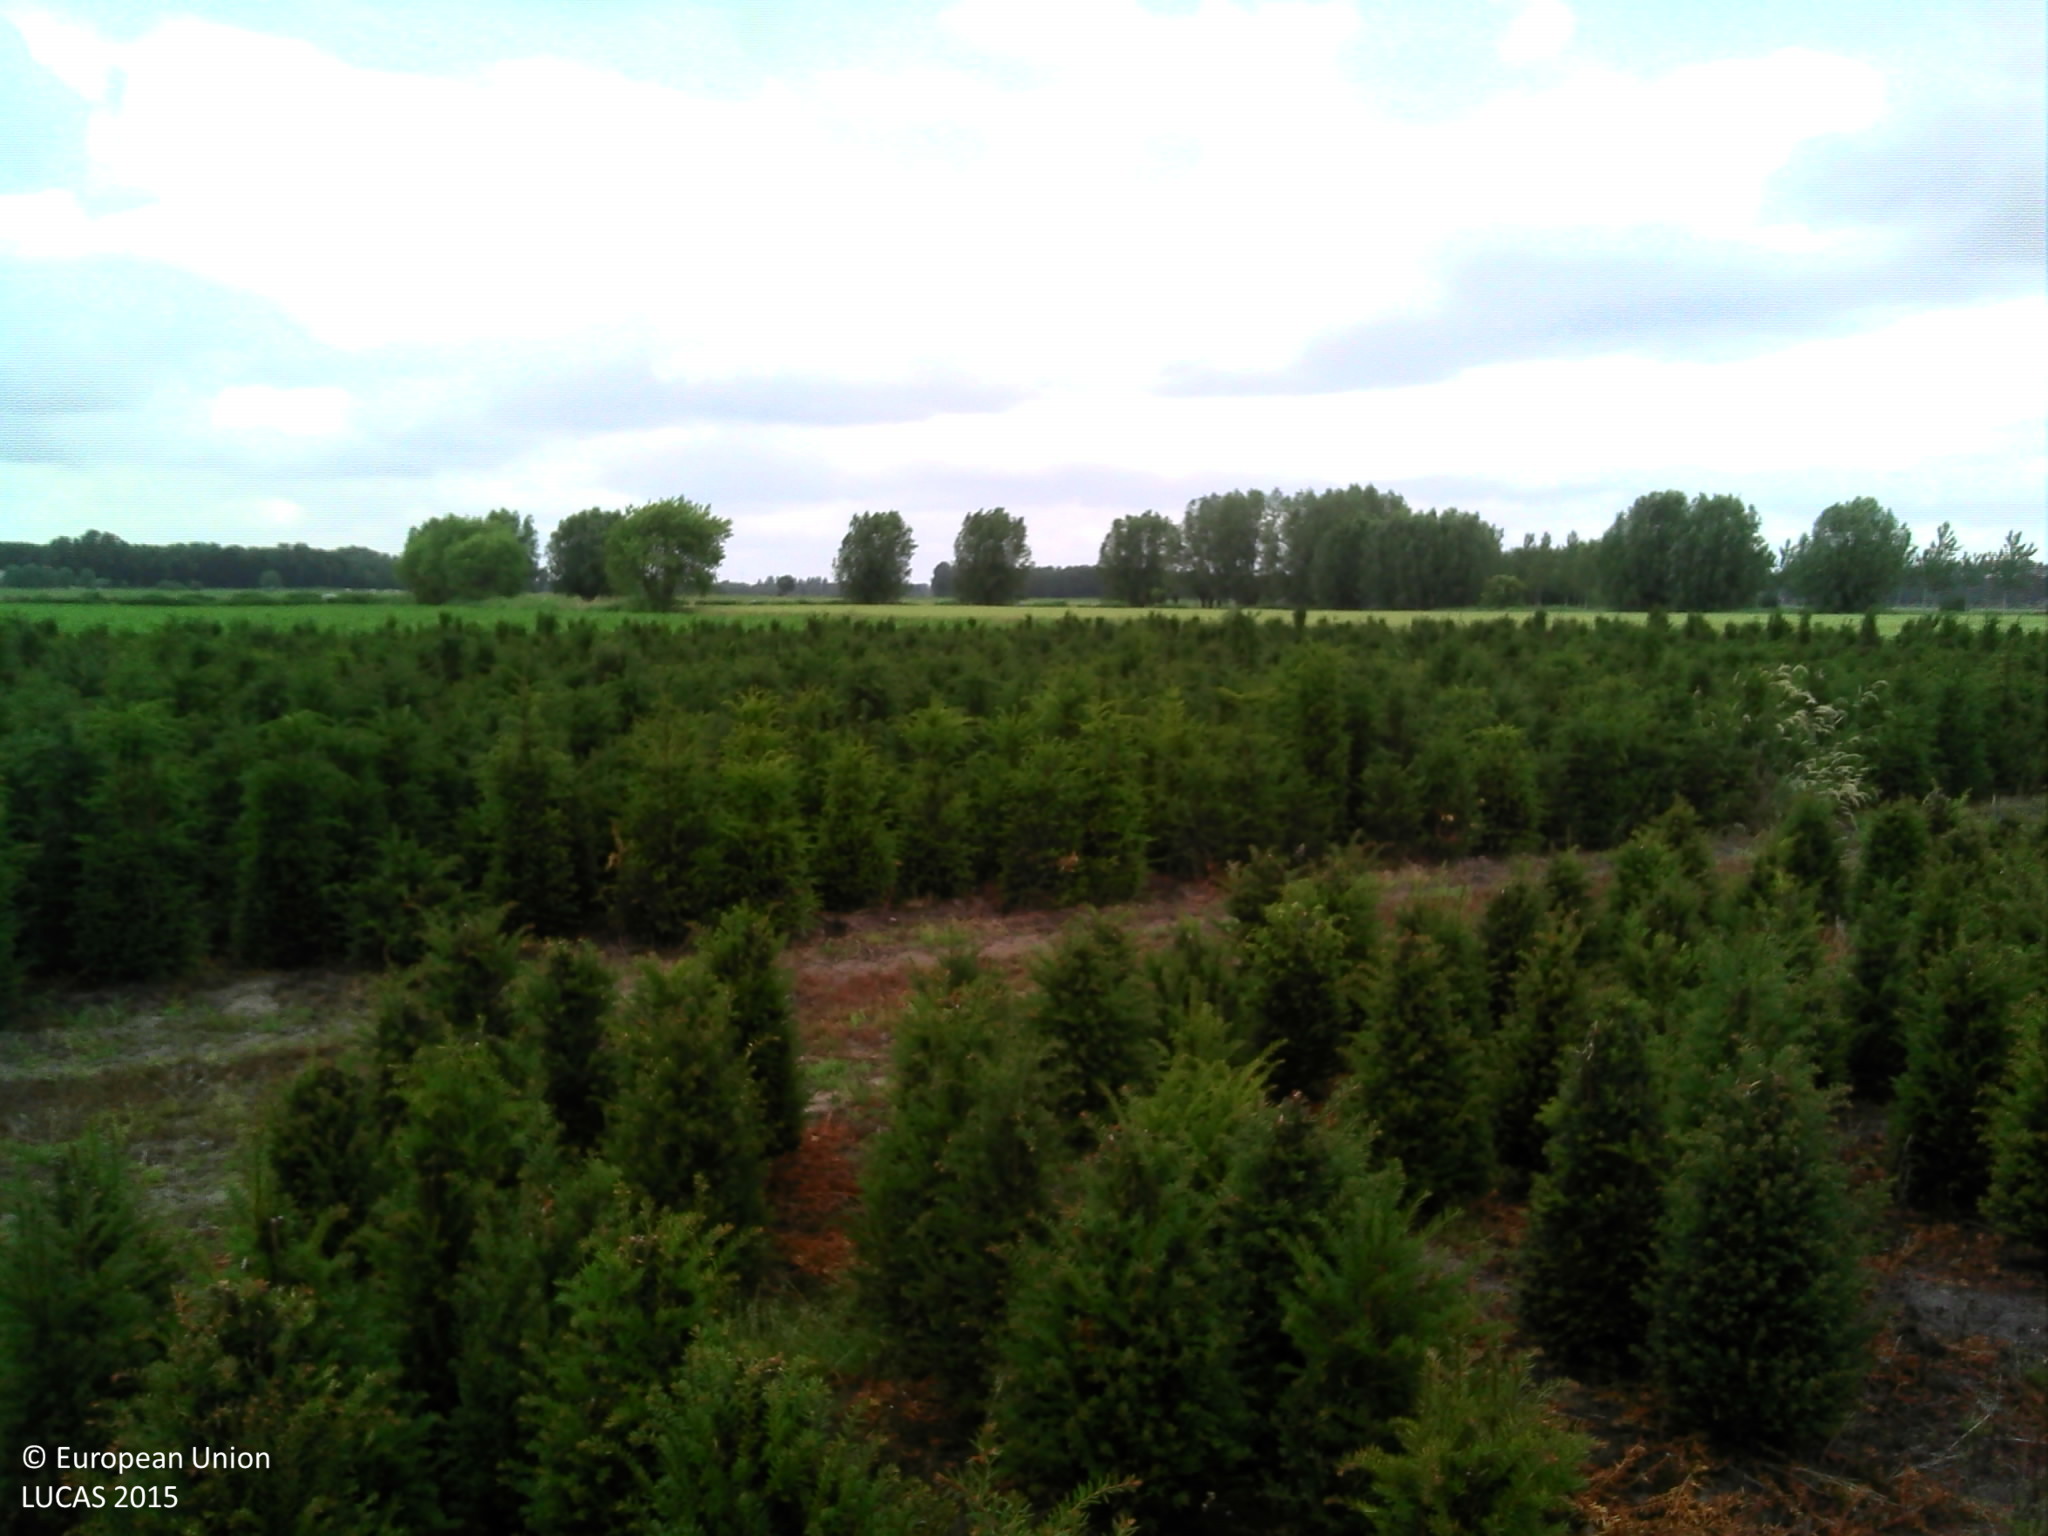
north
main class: Cropland
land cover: Nurseries
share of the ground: > 75 %
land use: Agriculture (excluding fallow land and kitchen gardens)
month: June
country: BE
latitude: 51.2101
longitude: 3.8814
